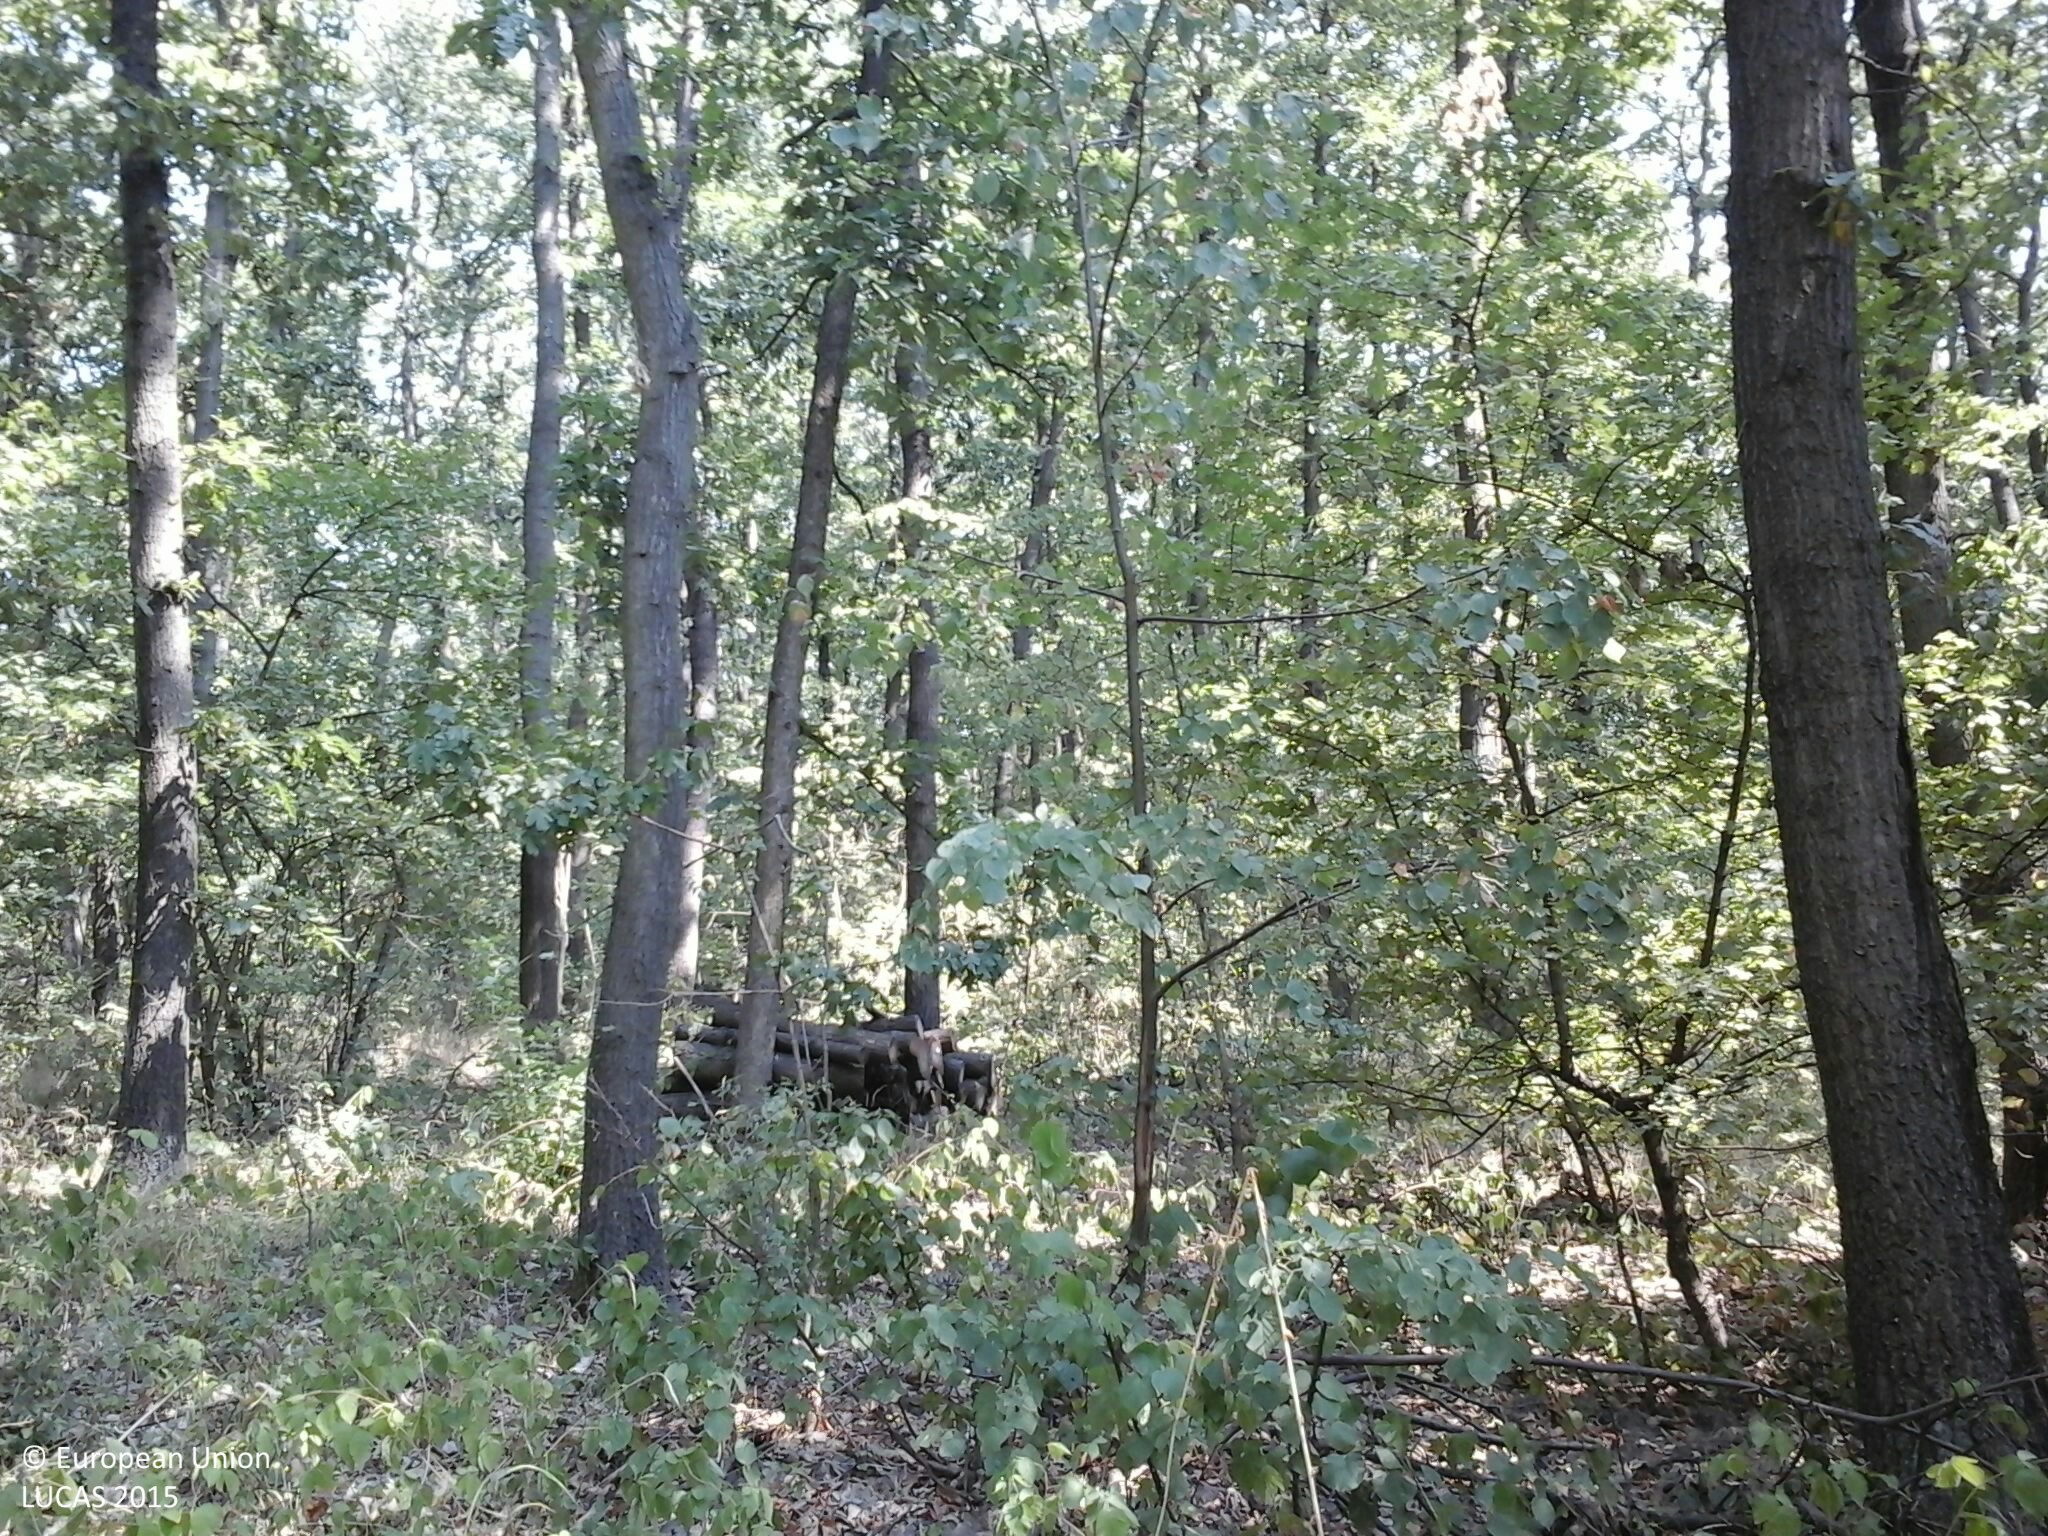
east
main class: Woodland
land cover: Broadleaved woodland
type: thermophilous deciduous forest
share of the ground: > 75 %
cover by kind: broadleaved forest trees 70 %, shrubs 20 %, herbaceous plants 10 %
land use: Forestry
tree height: > 5 m
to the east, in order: Broadleaved woodland; Tracks; Broadleaved woodland; Electric lines; Broadleaved woodland
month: August
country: HU
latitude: 47.9519
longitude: 19.1388
